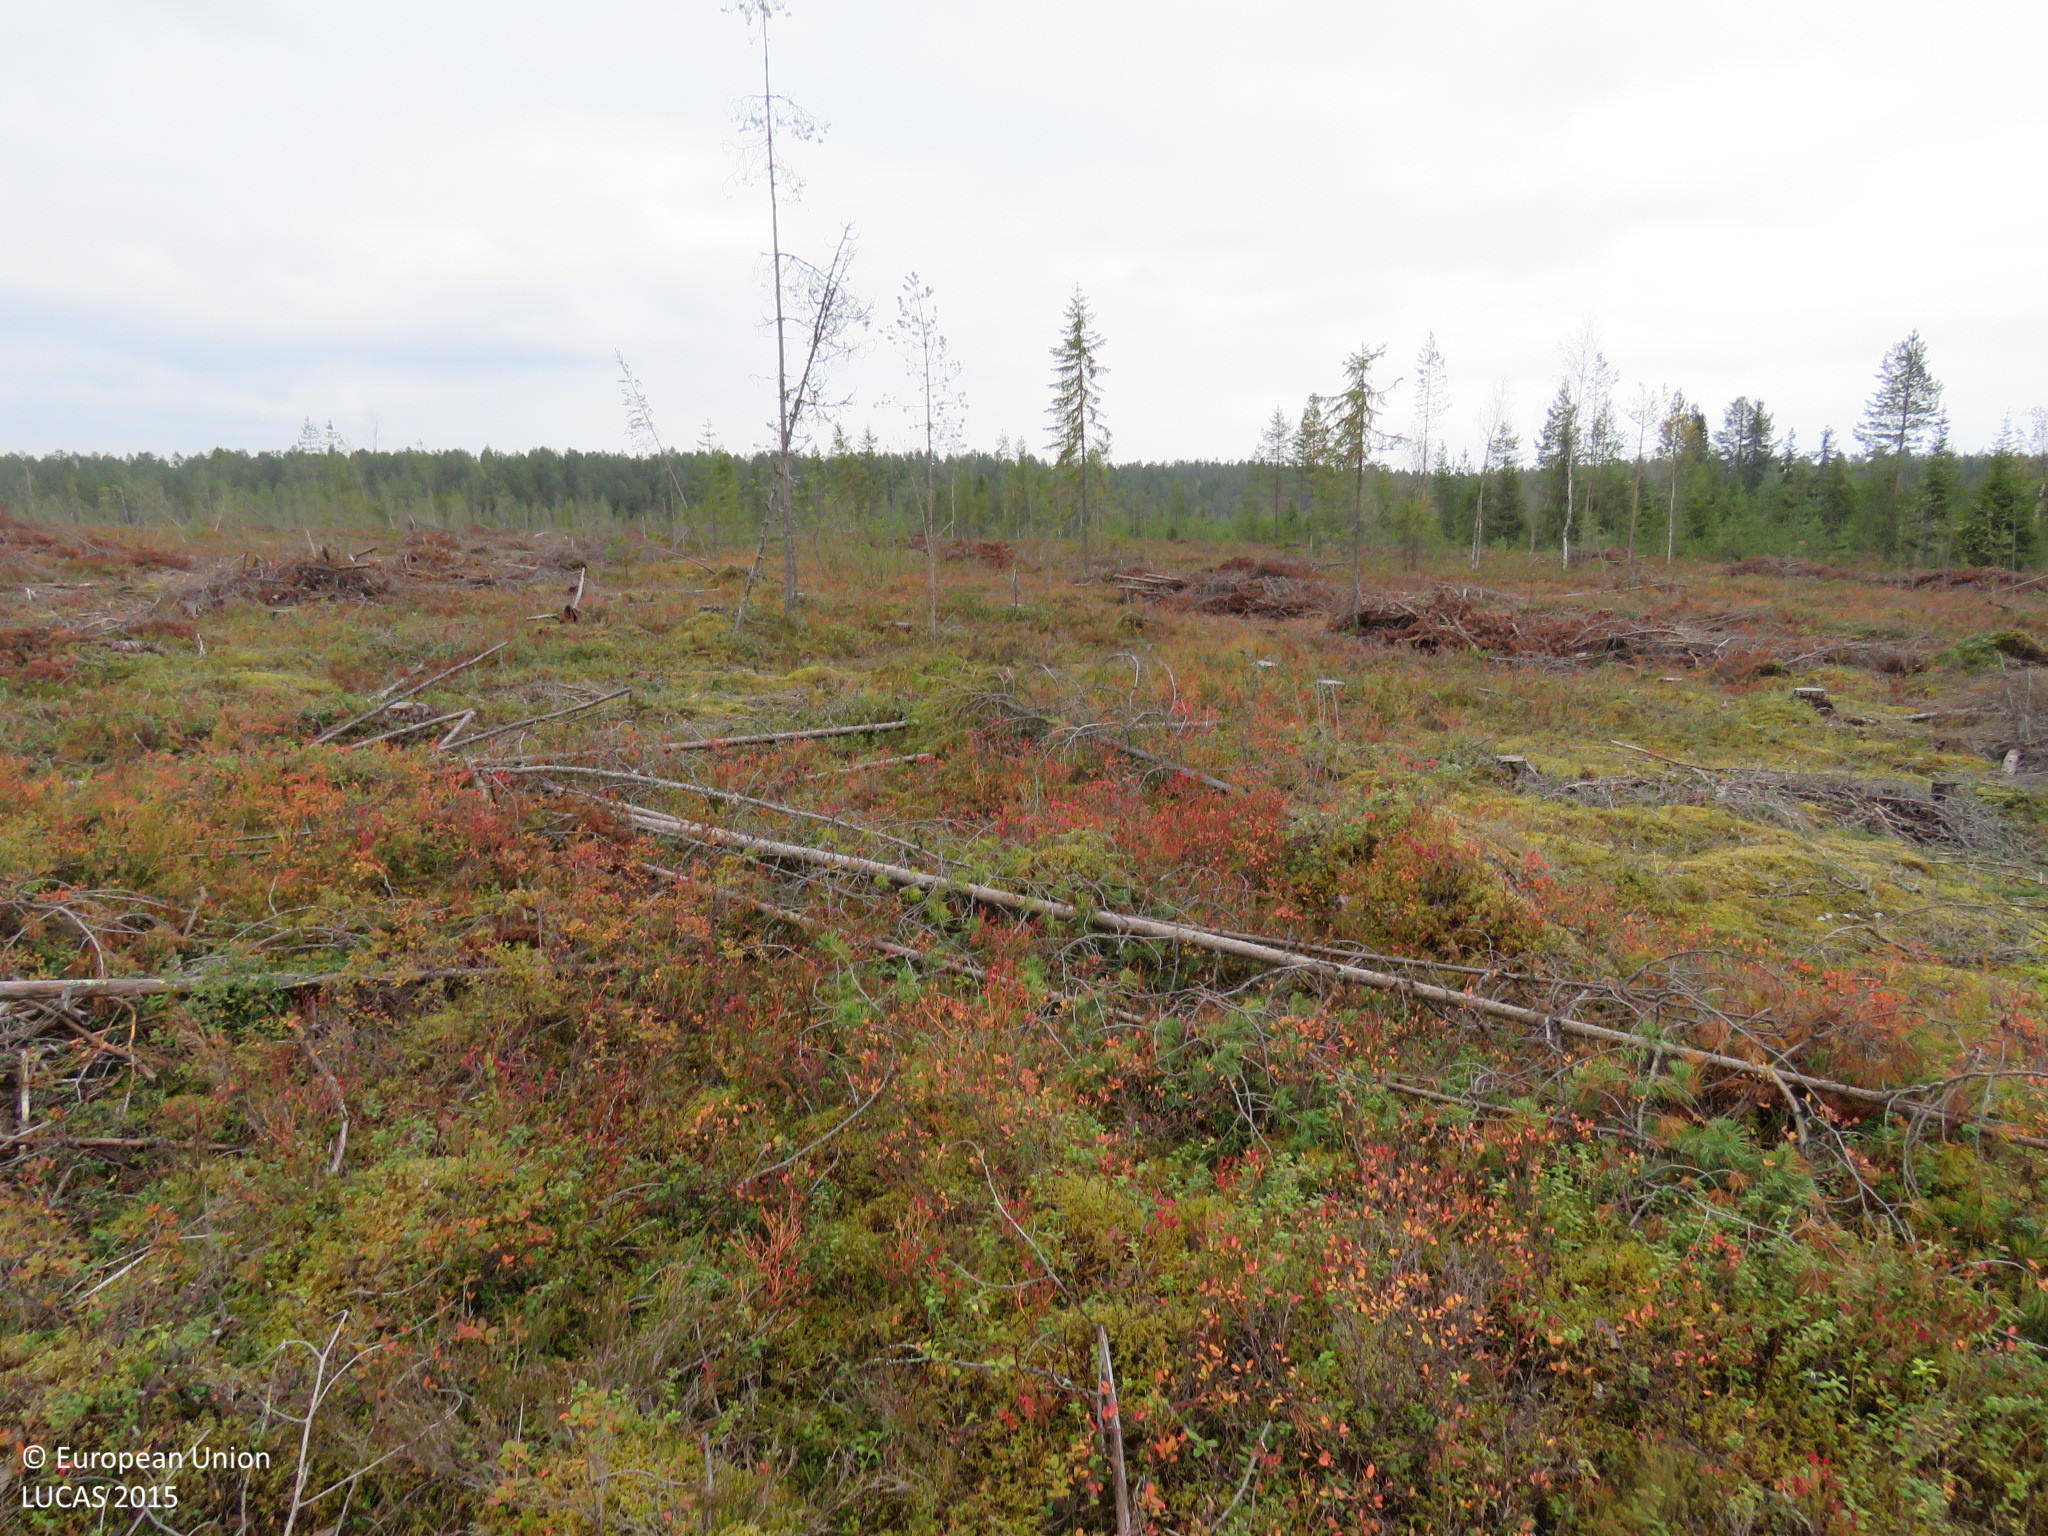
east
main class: Shrubland
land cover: Shrubland with sparse tree cover
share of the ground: 50 - 75 %
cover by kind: shrubs 55 %, lichens and mosses 30 %, coniferous forest trees 5 %, unconsolidated bare surface 5 %
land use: Forestry
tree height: < 5 m
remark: Clear cut
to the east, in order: Shrubland with sparse tree cover; Other coniferous woodland; Shrubland with sparse tree cover; Other mixed woodland; Shrubland with sparse tree cover; Tracks
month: September
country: FI
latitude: 65.2923
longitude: 26.6389
